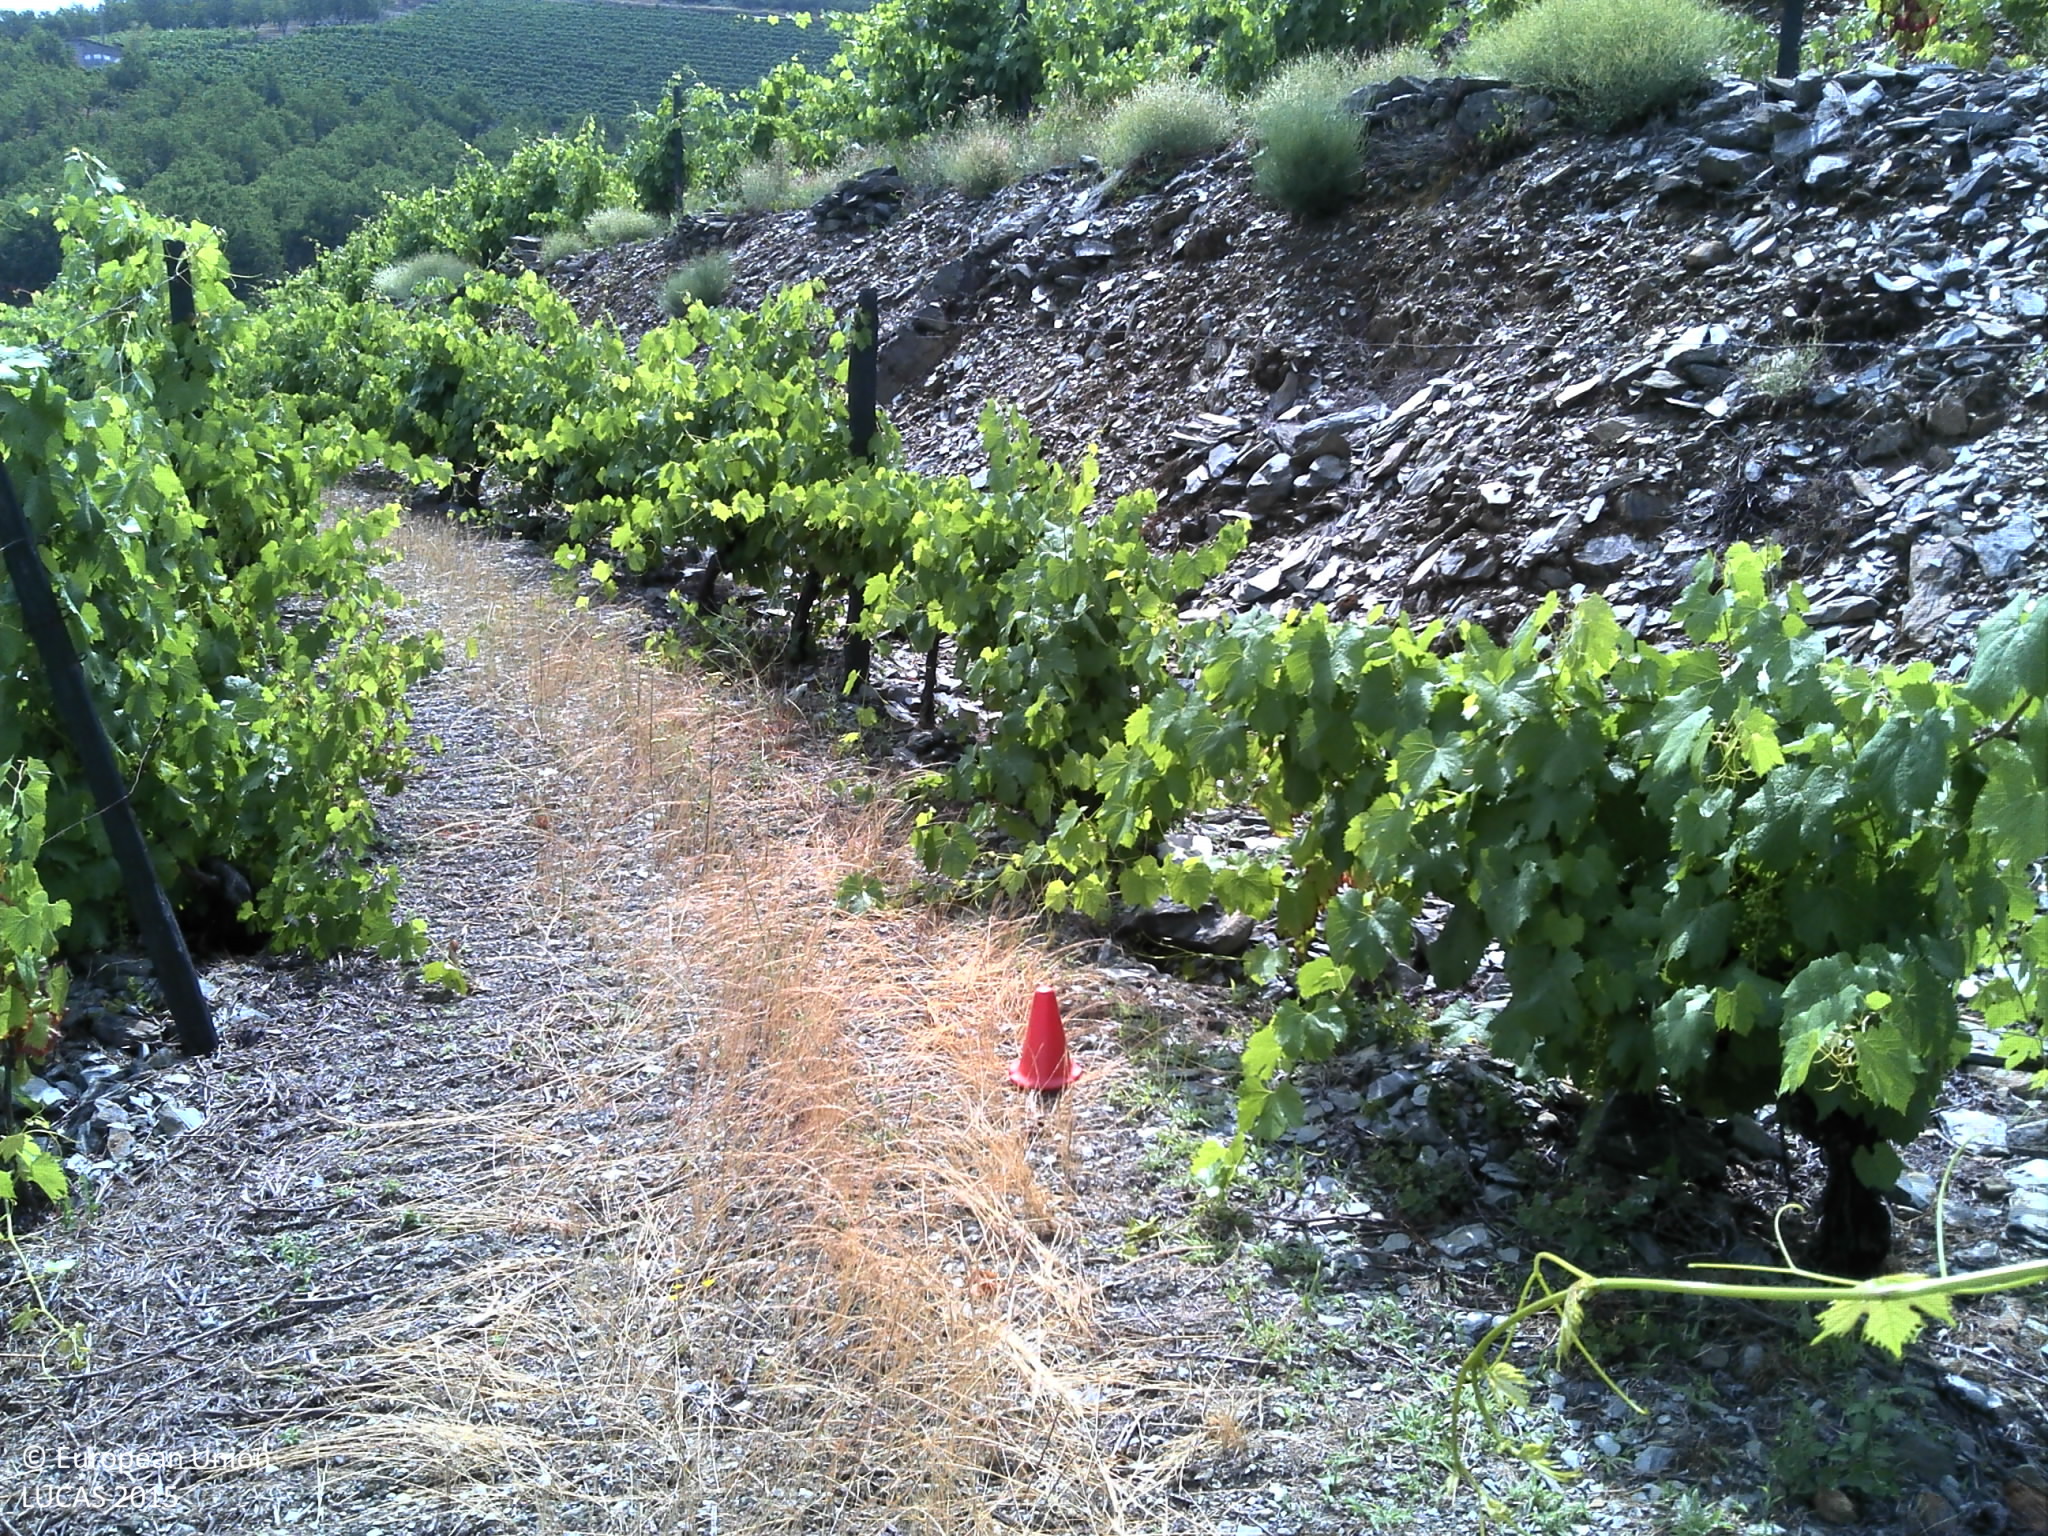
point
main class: Cropland
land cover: Vineyards
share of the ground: < 10 %
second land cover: Spontaneously vegetated surfaces
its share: 10 - 25 %
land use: Agriculture (excluding fallow land and kitchen gardens)
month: June
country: PT
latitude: 41.1686
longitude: -7.4141
